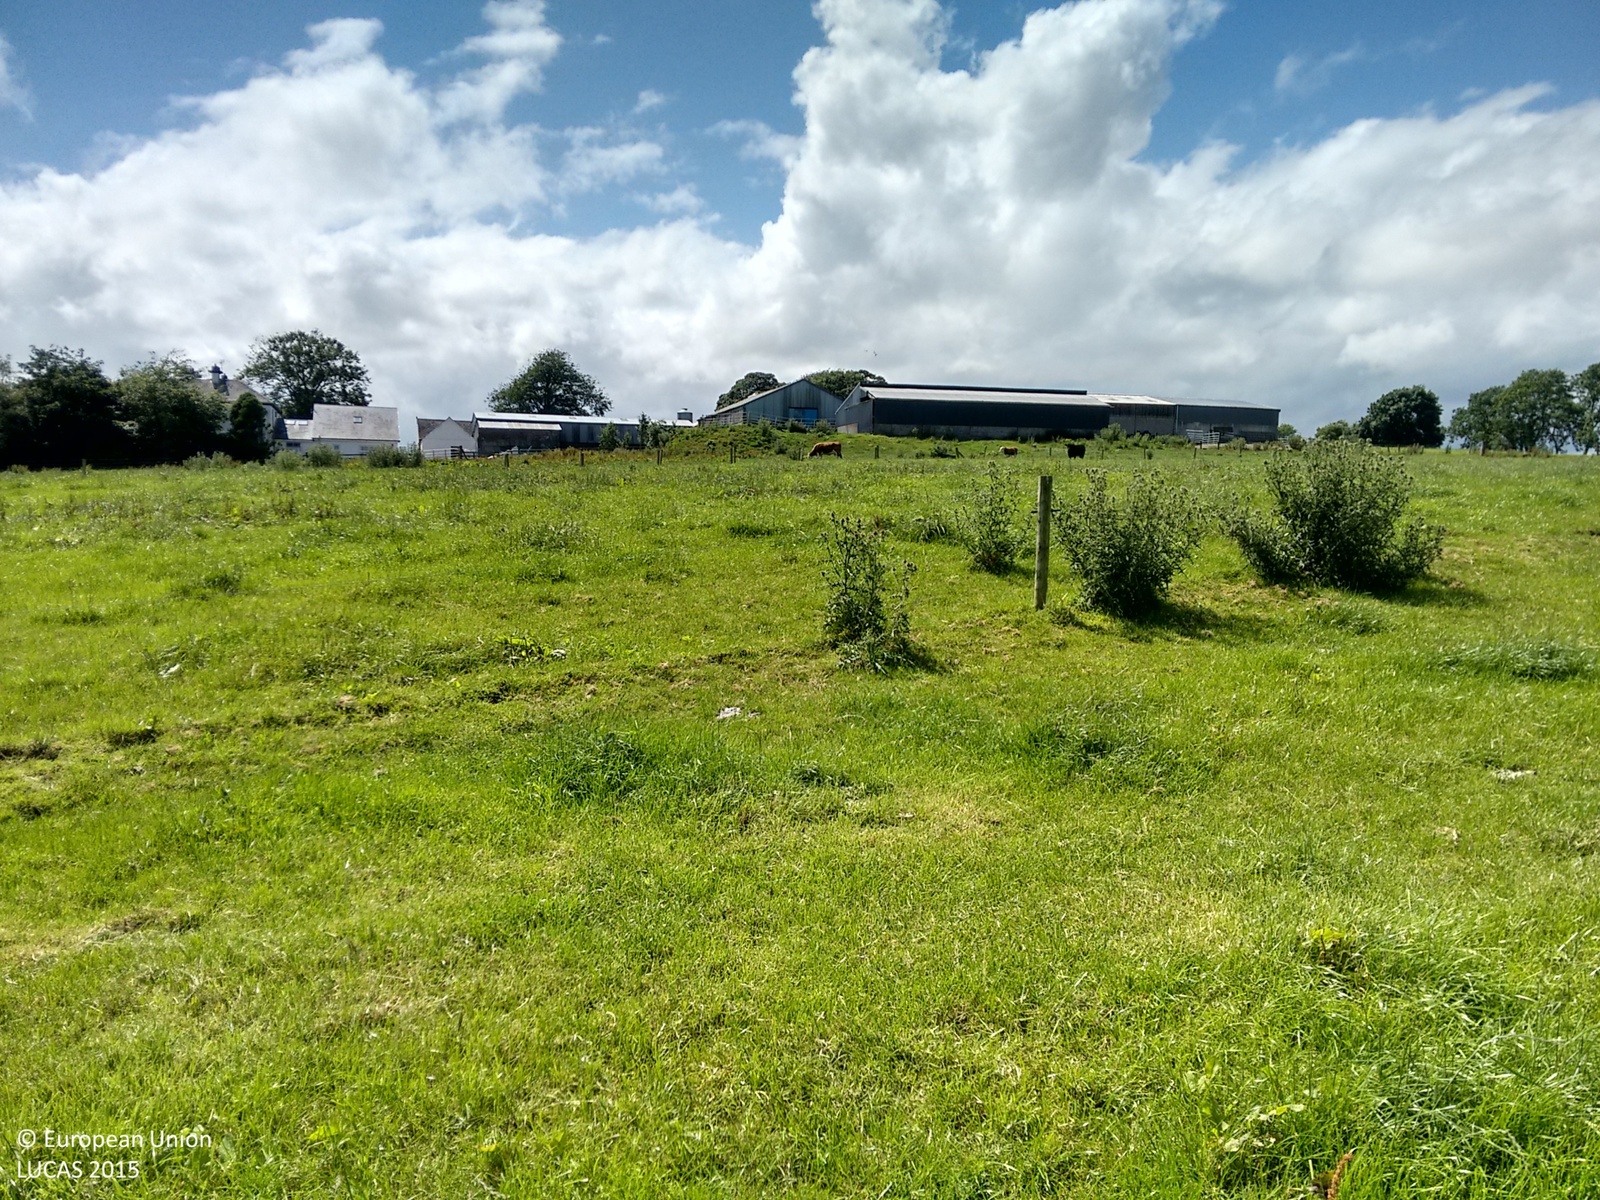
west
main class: Grassland
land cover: Grassland without tree/shrub cover
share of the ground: > 75 %
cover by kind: herbaceous plants 100 %
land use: Agriculture (excluding fallow land and kitchen gardens)
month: July
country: IE
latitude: 52.6951
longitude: -7.4238
